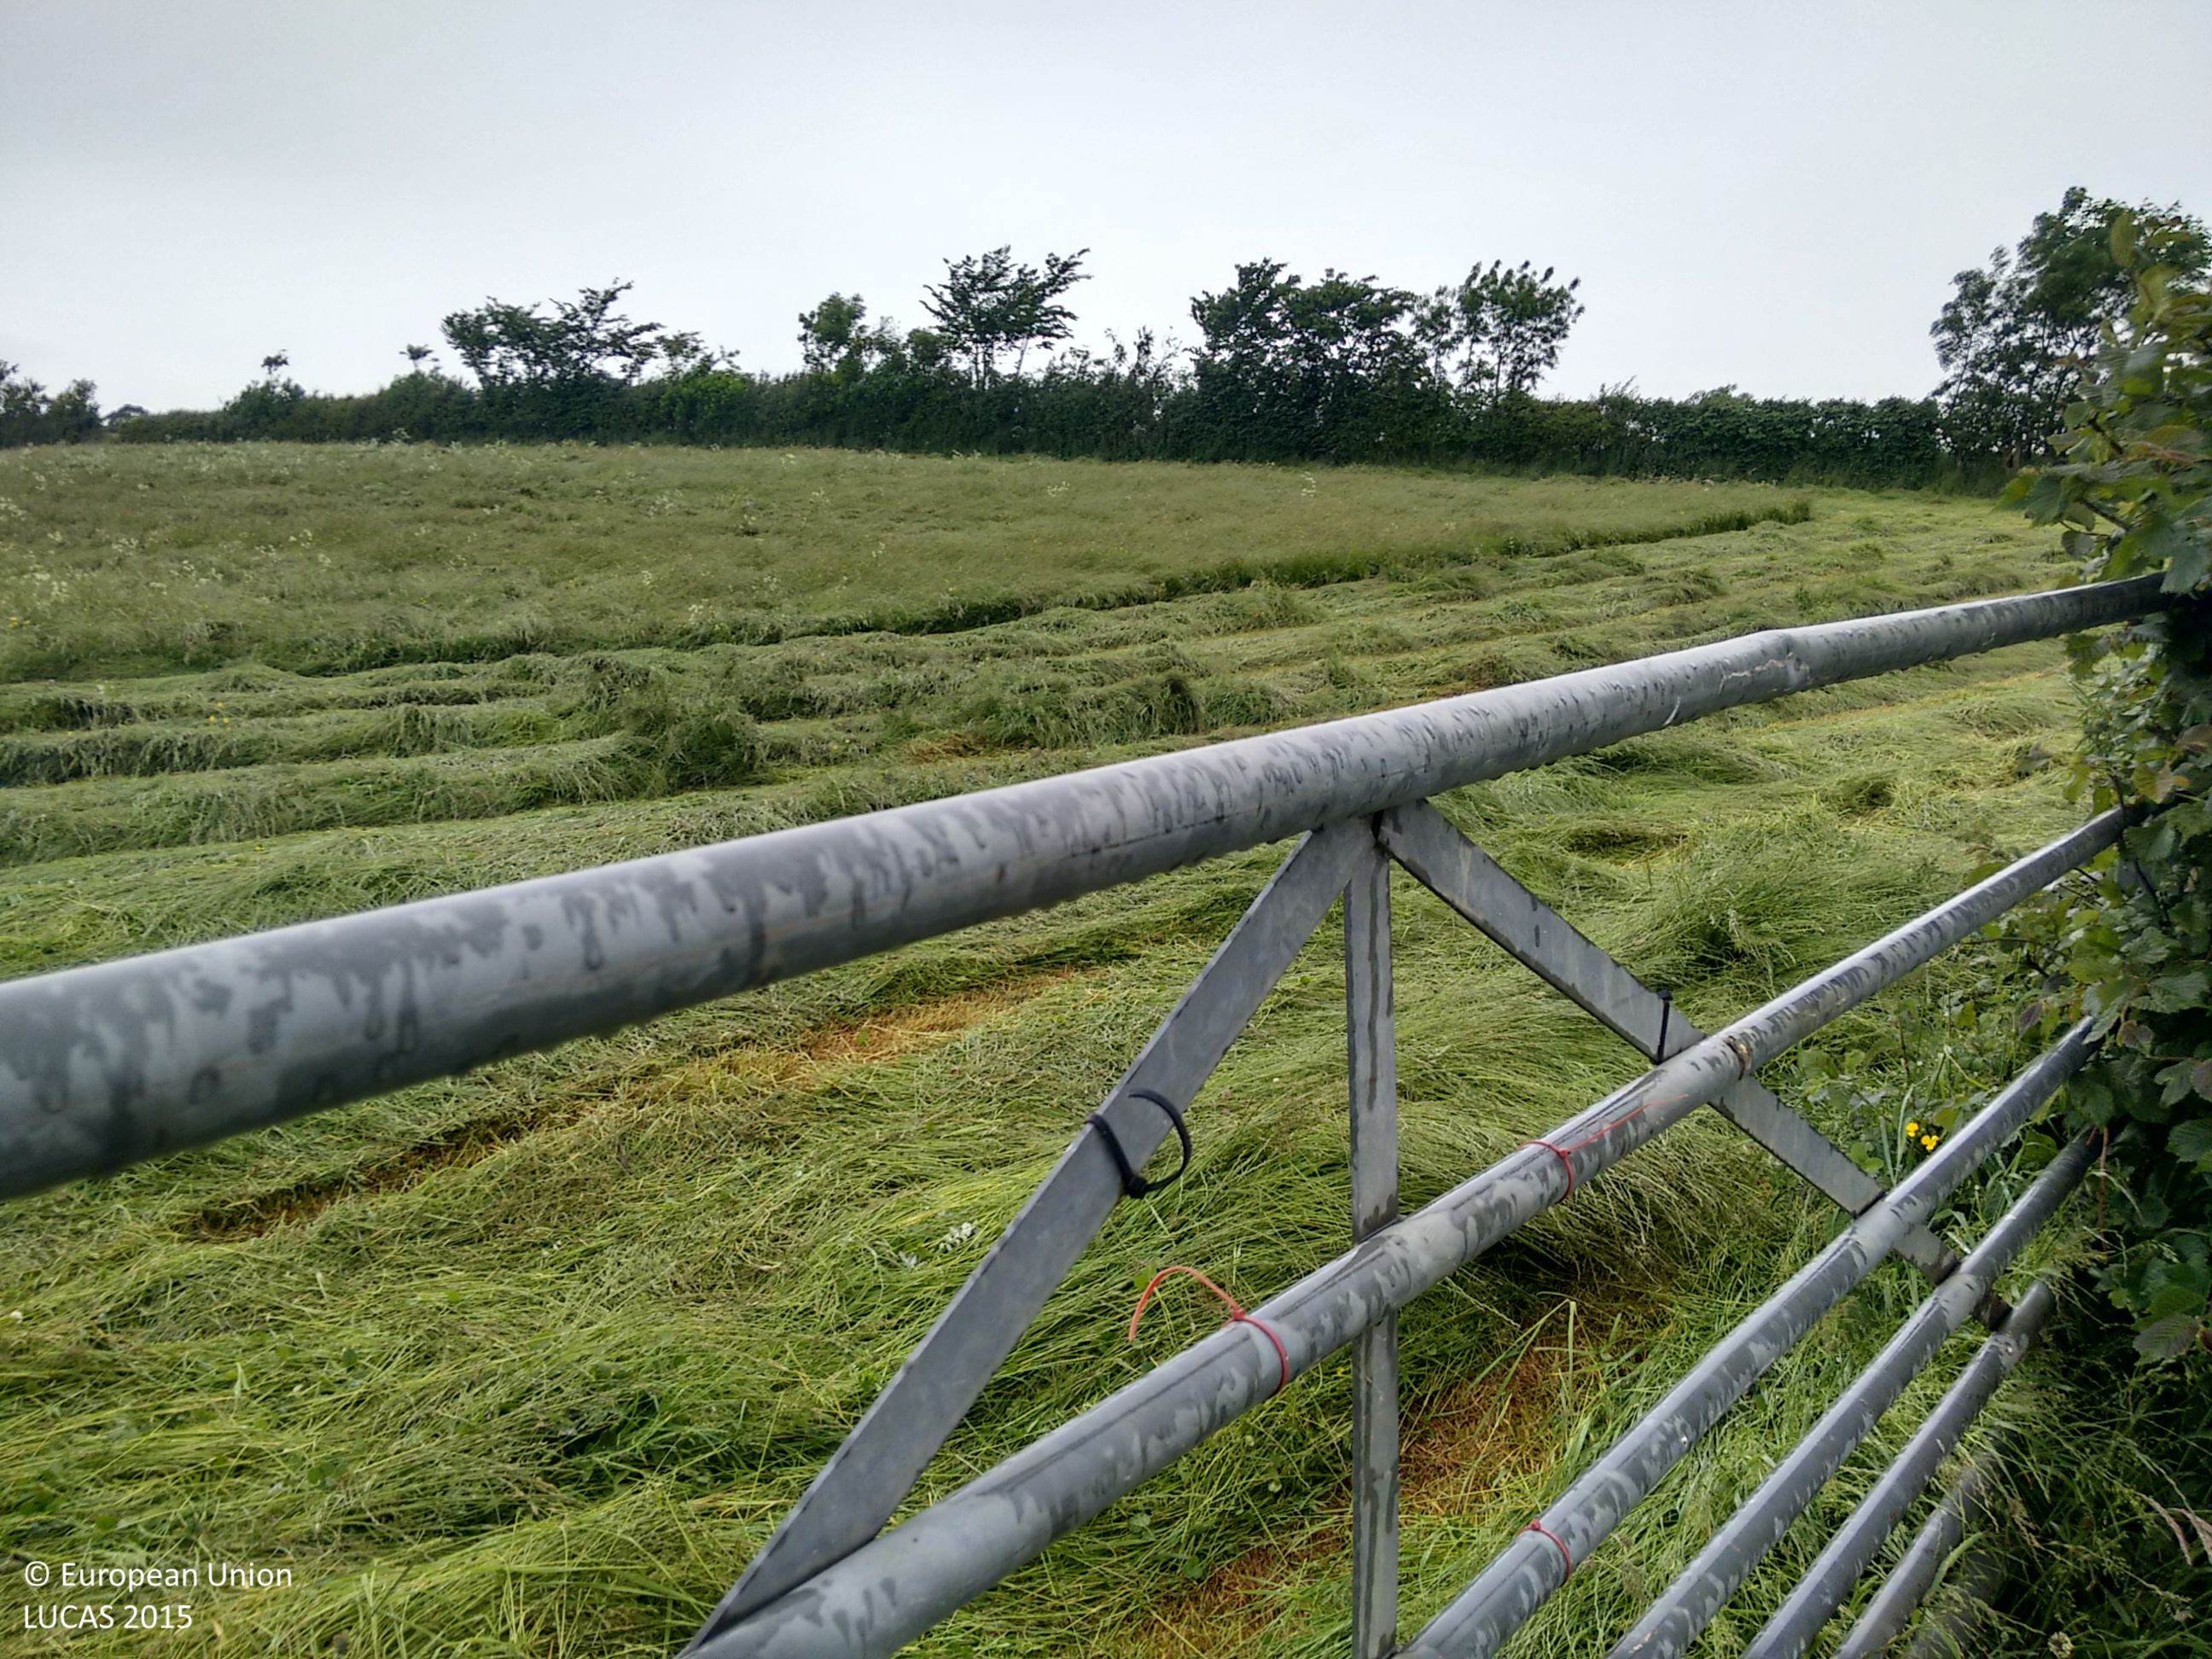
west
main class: Grassland
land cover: Grassland without tree/shrub cover
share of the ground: > 75 %
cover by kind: herbaceous plants 100 %
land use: Agriculture (excluding fallow land and kitchen gardens)
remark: Harvested field
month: June
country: GB
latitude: 54.2560
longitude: -1.6402
